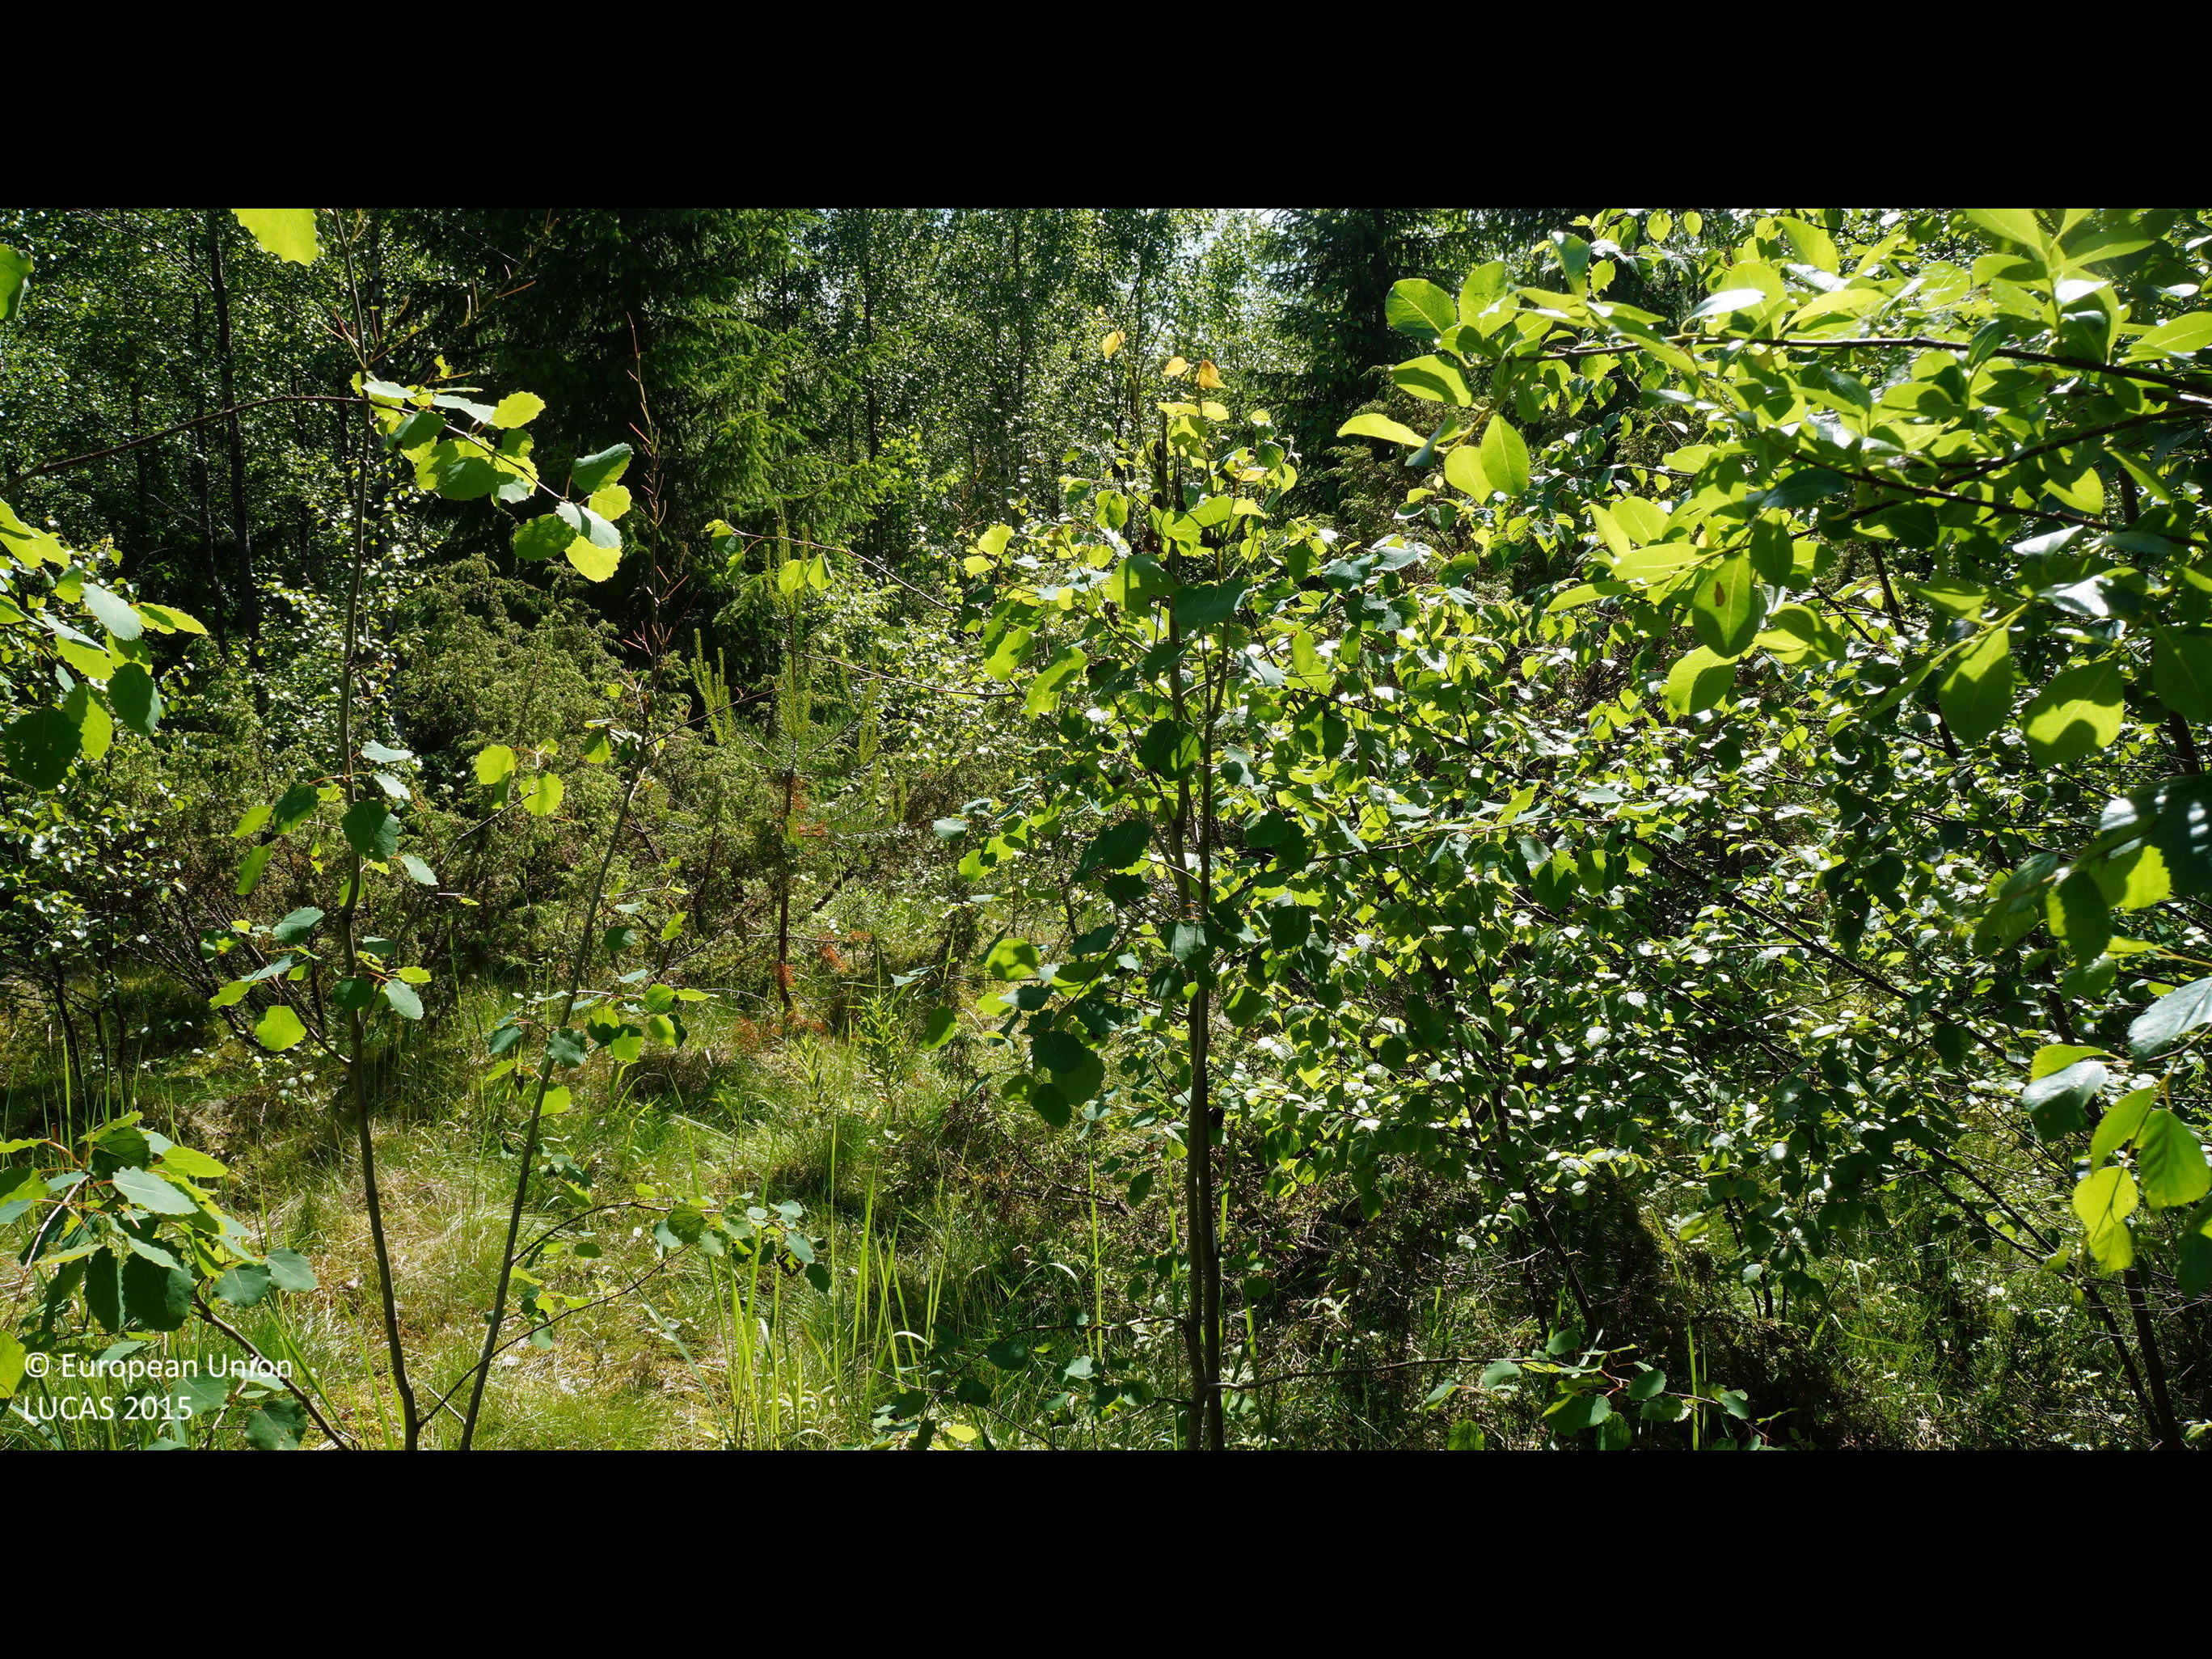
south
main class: Woodland
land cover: Broadleaved woodland
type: boreal forest
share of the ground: 50 - 75 %
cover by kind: broadleaved forest trees 40 %, shrubs 30 %, herbaceous plants 20 %, coniferous forest trees 10 %
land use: Forestry
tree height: > 5 m
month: July
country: FI
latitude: 64.1740
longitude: 24.4530
